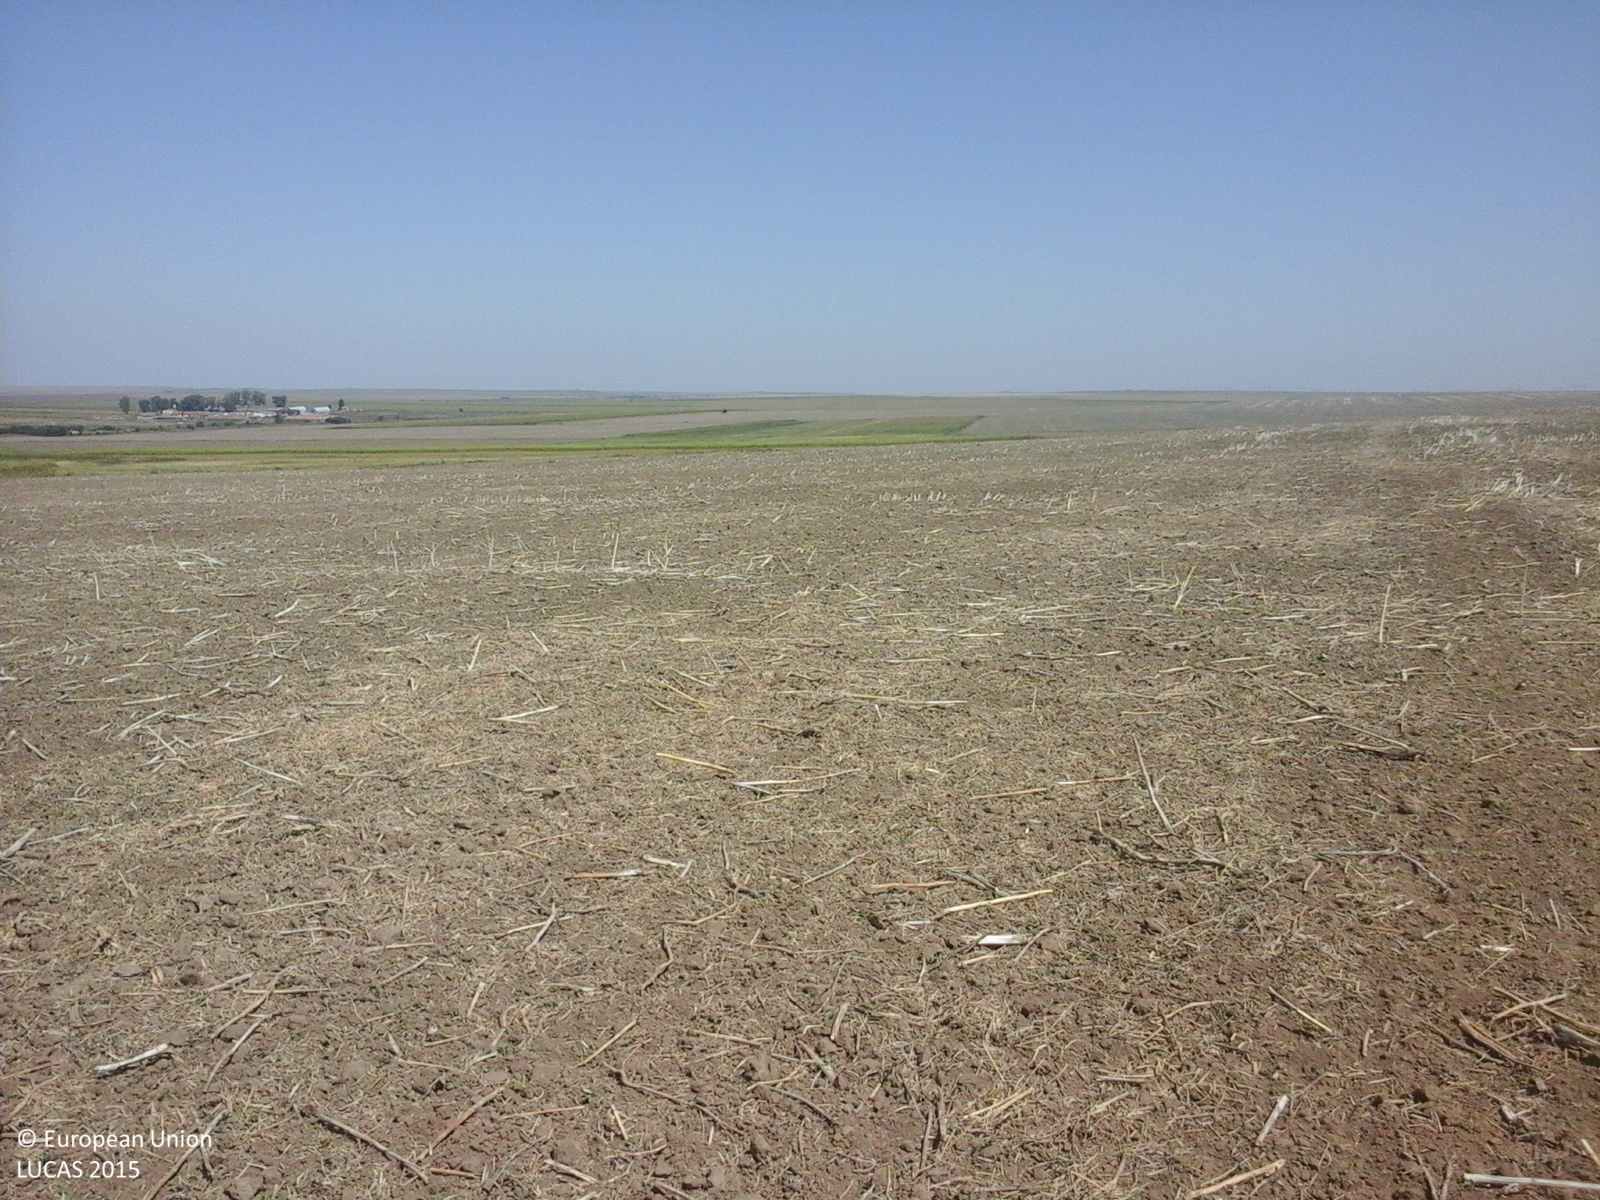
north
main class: Cropland
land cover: Rape and turnip rape
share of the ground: < 10 %
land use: Agriculture (excluding fallow land and kitchen gardens)
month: August
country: RO
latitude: 44.5898
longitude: 28.1902
